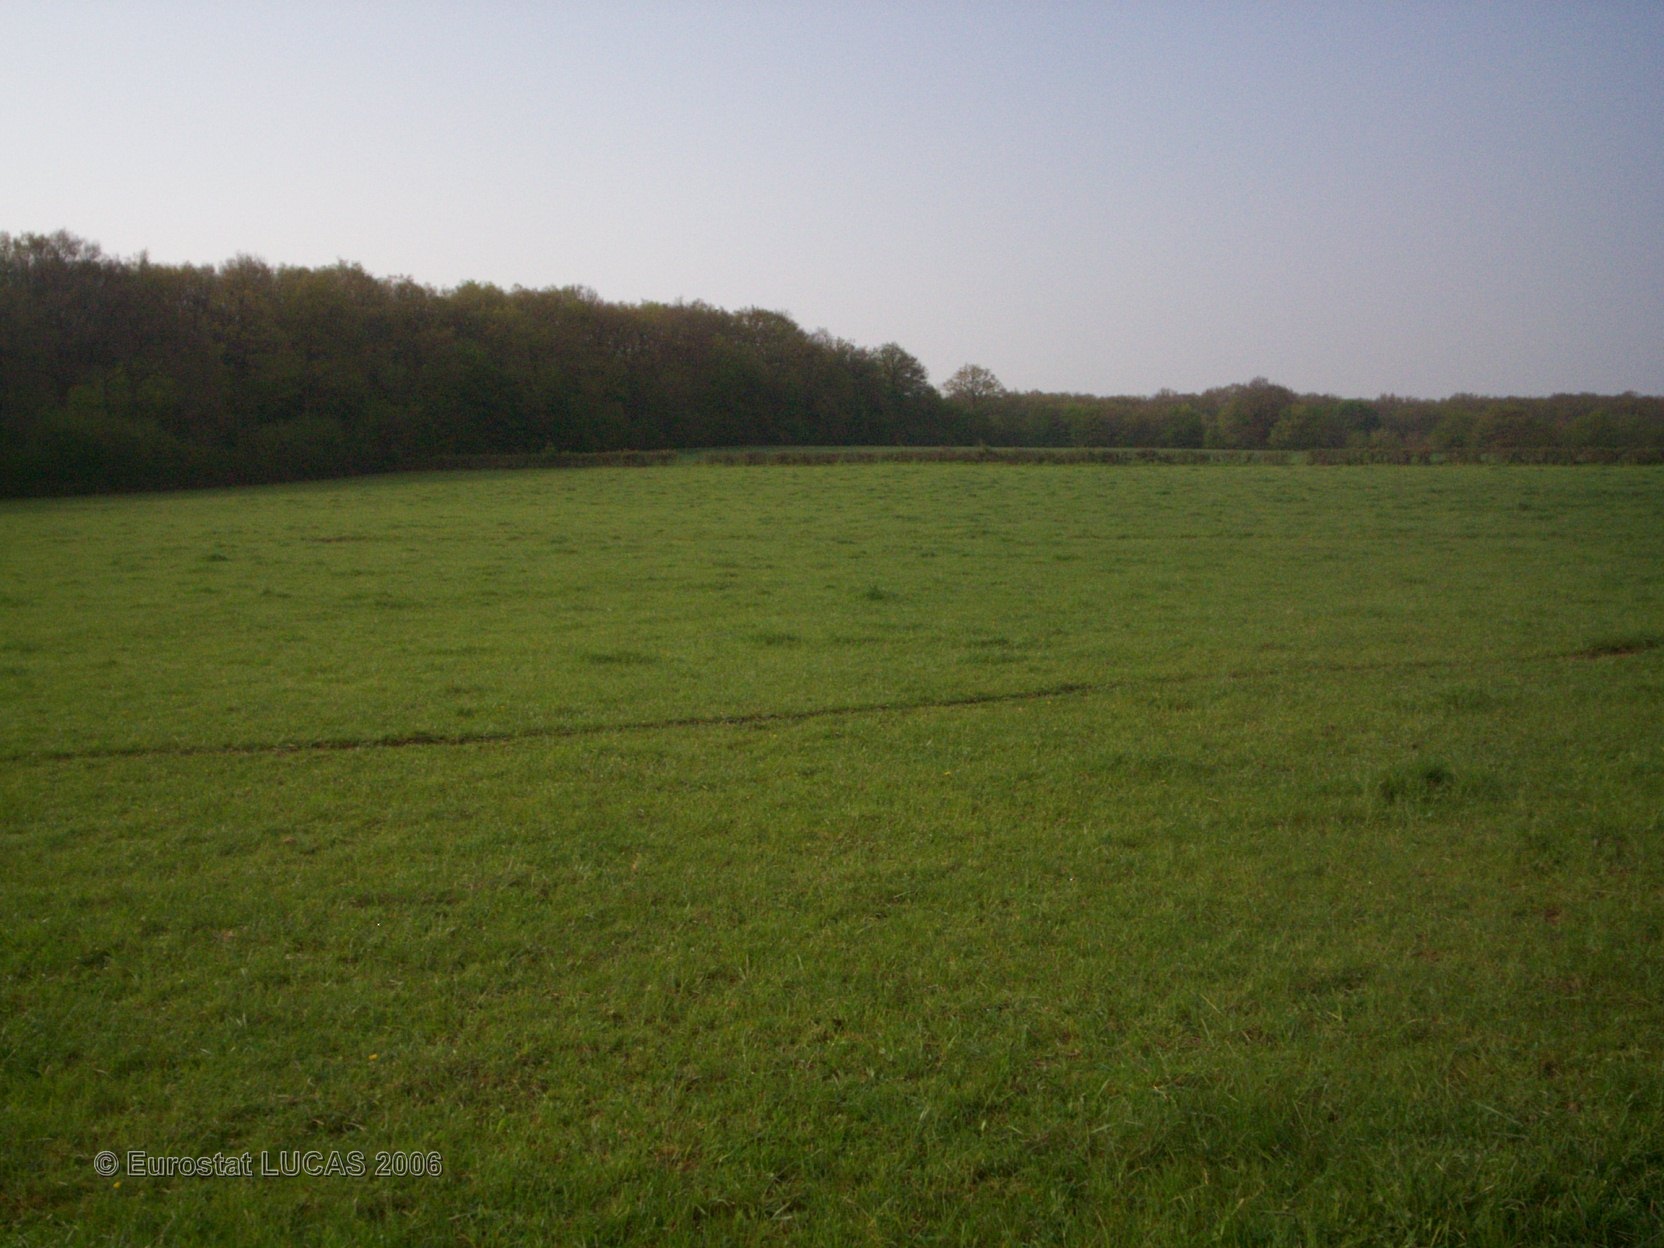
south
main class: Grassland
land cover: Grassland without tree/shrub cover
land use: Agriculture (excluding fallow land and kitchen gardens)
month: April
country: FR
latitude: 47.2119
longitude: 3.0901
